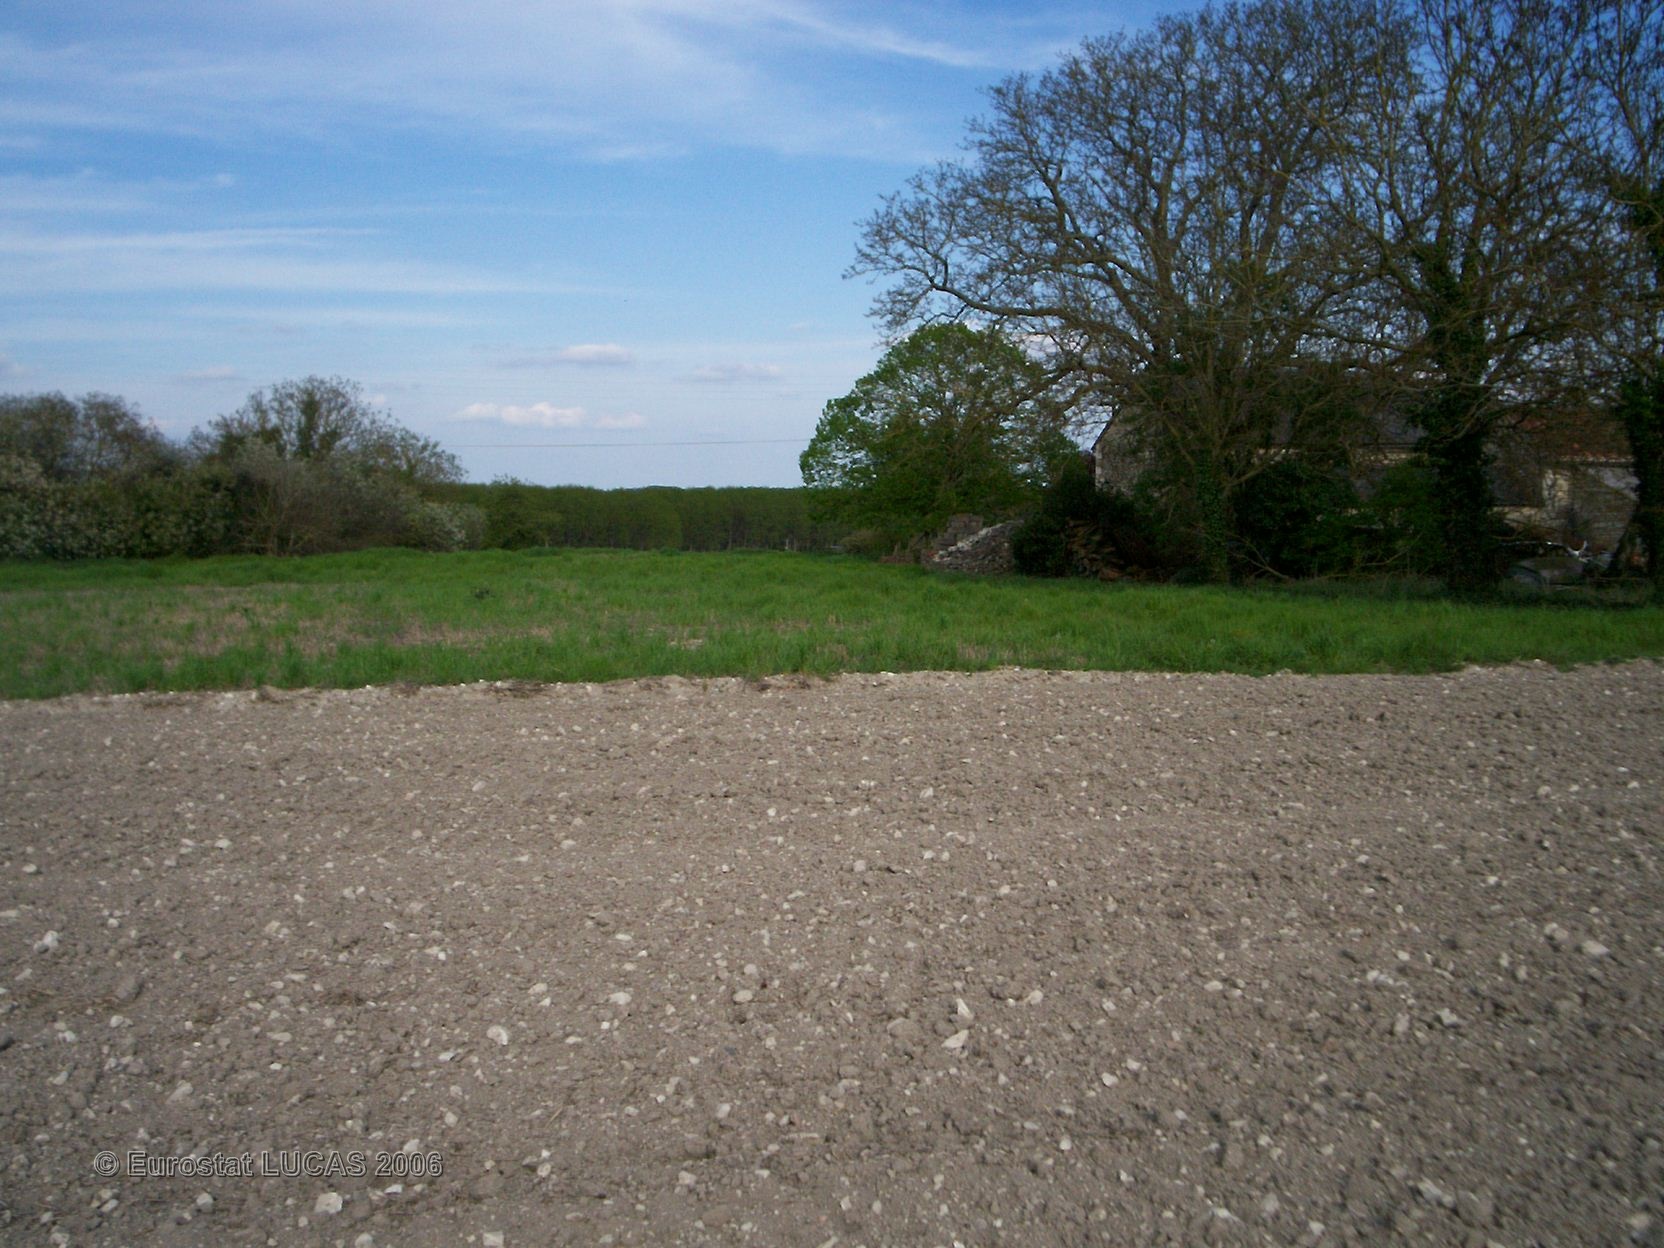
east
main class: Bare land
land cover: Bare land
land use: Agriculture (excluding fallow land and kitchen gardens)
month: April
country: FR
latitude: 46.9520
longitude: 0.4012
